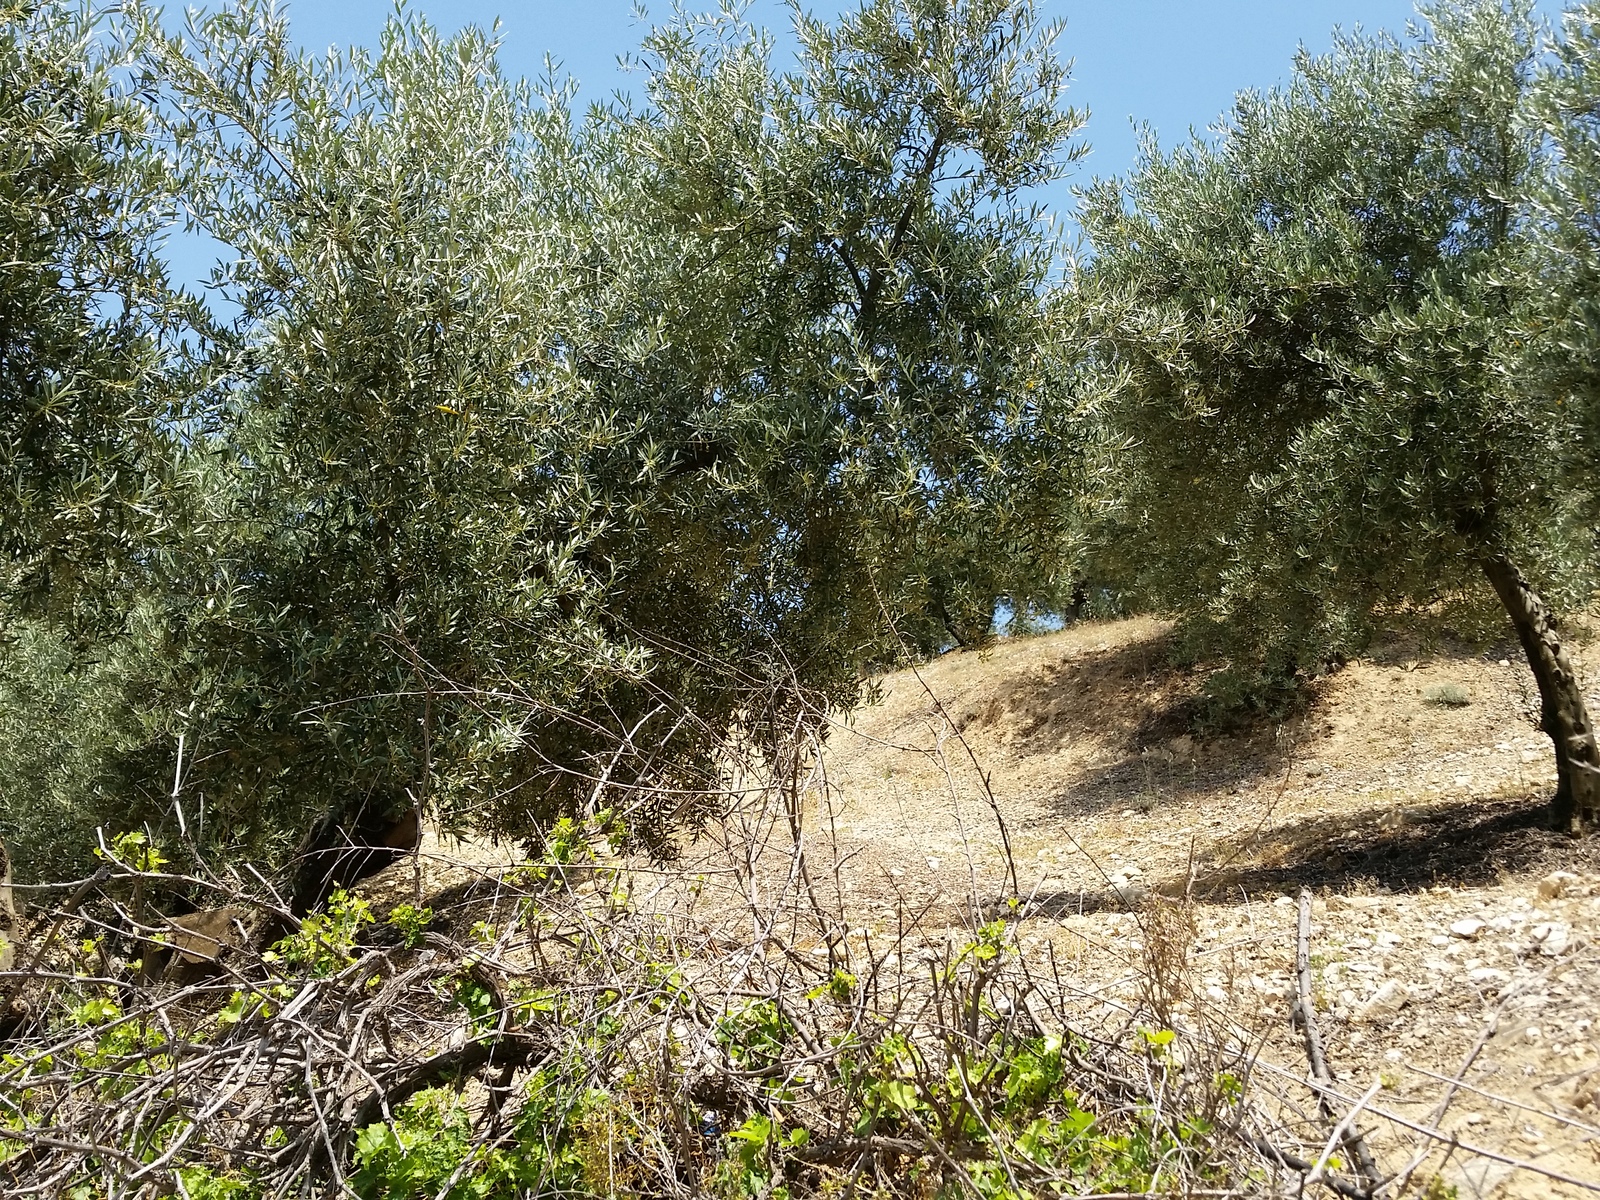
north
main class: Cropland
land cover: Olive groves
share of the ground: 50 - 75 %
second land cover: Other bare soil
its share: > 75 %
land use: Agriculture (excluding fallow land and kitchen gardens)
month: June
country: ES
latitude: 38.3747
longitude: -2.5777
